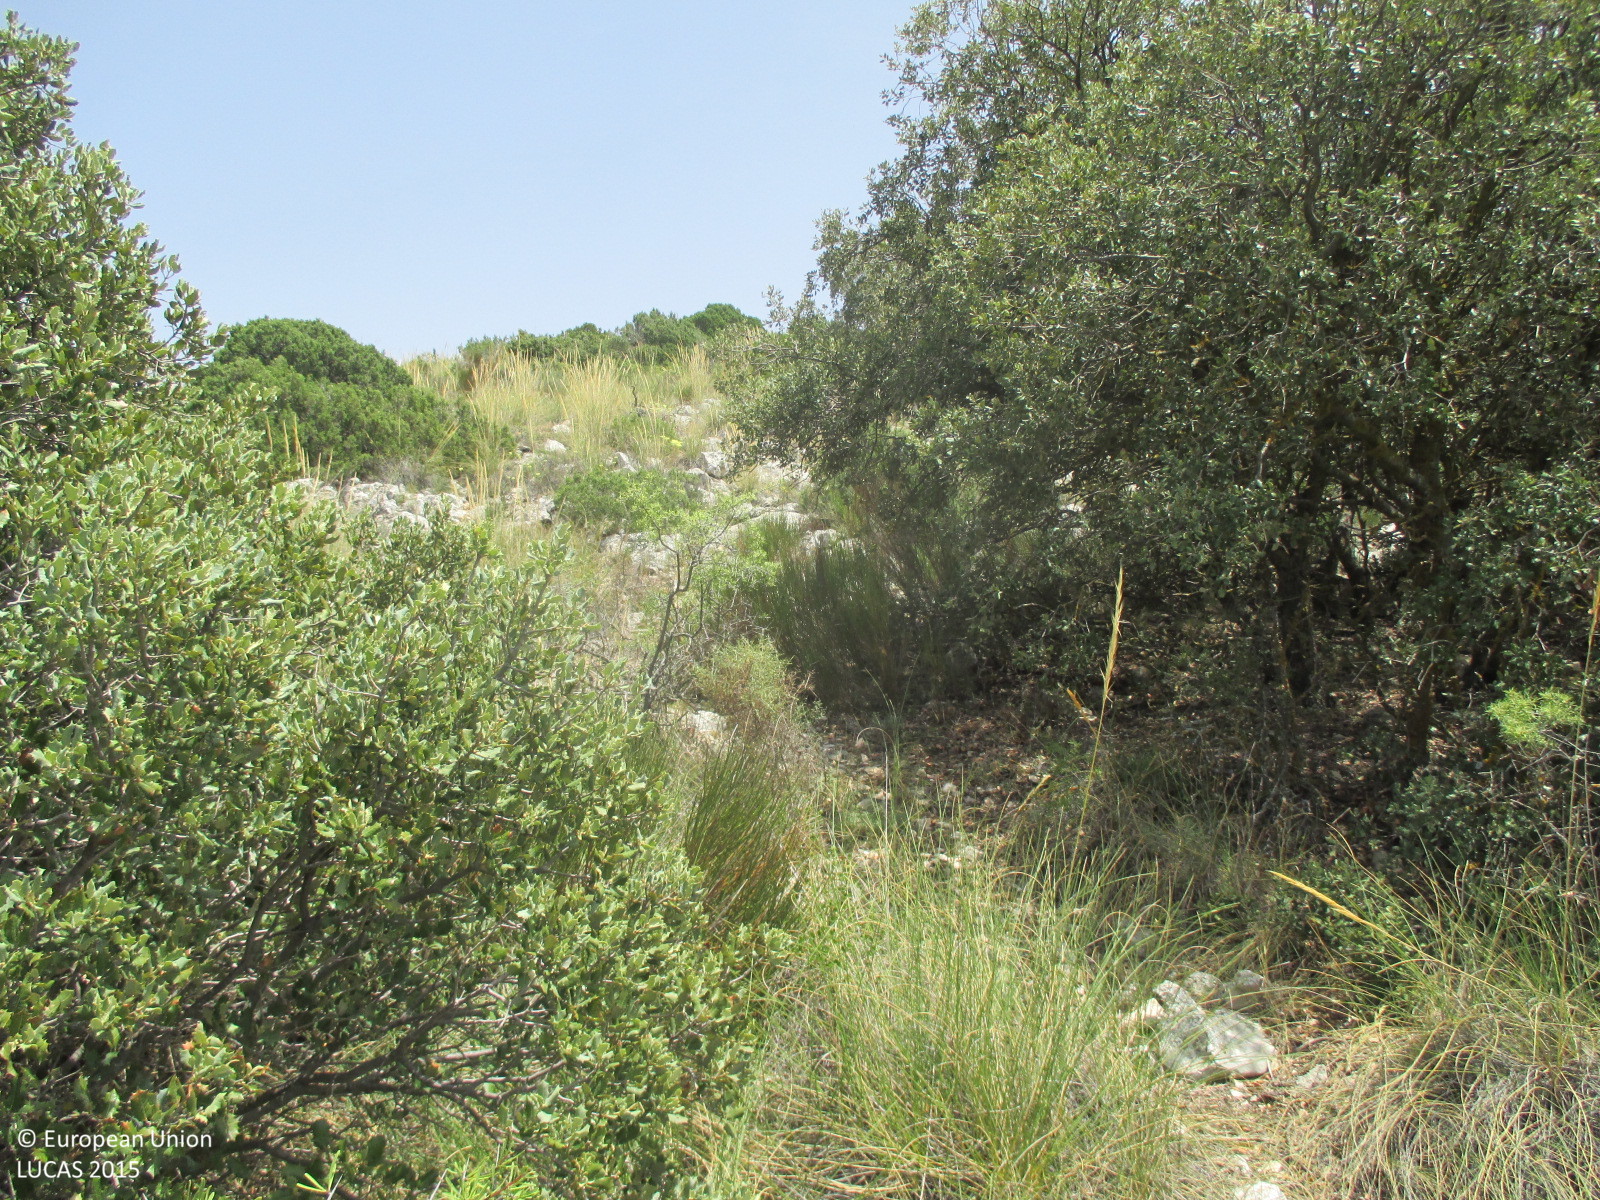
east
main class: Woodland
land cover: Broadleaved woodland
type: broadleaved evergreen forest
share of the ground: 50 - 75 %
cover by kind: broadleaved forest trees 50 %, herbaceous plants 40 %, shrubs 10 %
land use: Semi-natural and natural areas not in use
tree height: < 5 m
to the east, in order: Broadleaved woodland; Shrubland without tree cover; Grassland without tree/shrub cover
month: July
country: ES
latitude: 37.9247
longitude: -2.3791
